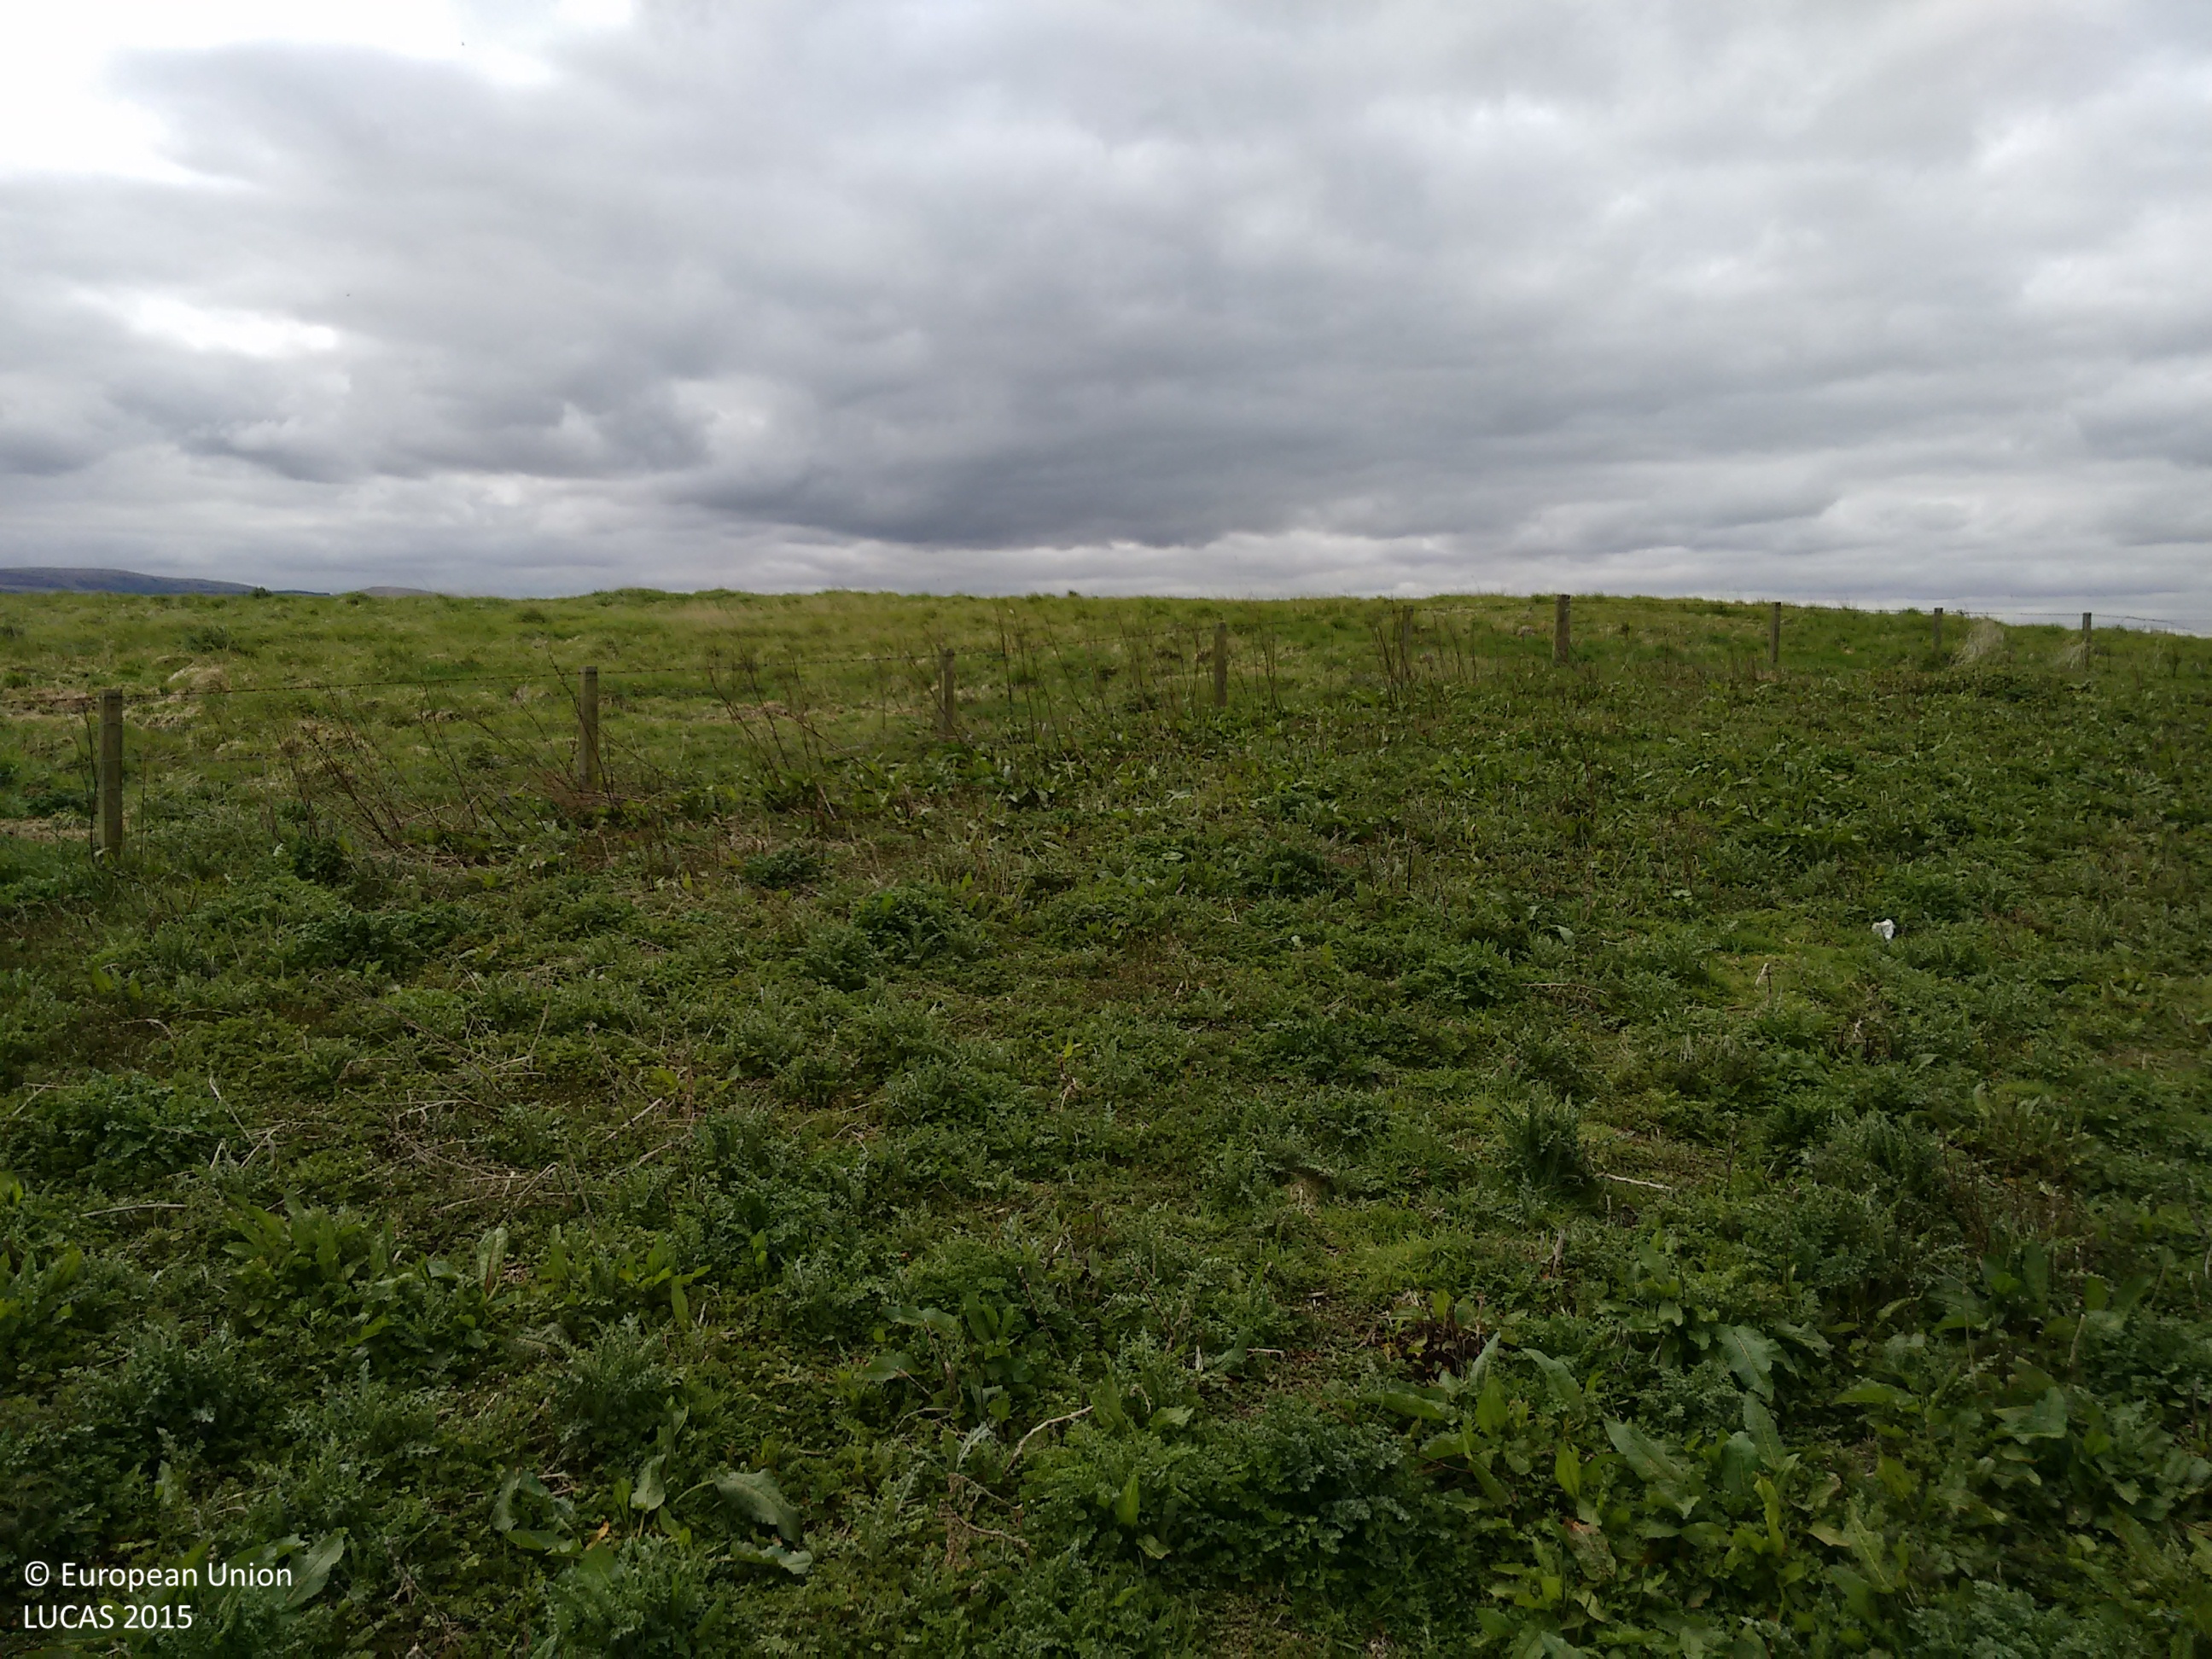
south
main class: Grassland
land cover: Spontaneously vegetated surfaces
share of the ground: > 75 %
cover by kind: herbaceous plants 90 %, unconsolidated bare surface 10 %
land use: Semi-natural and natural areas not in use
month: May
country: GB
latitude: 55.9459
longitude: -3.3161
